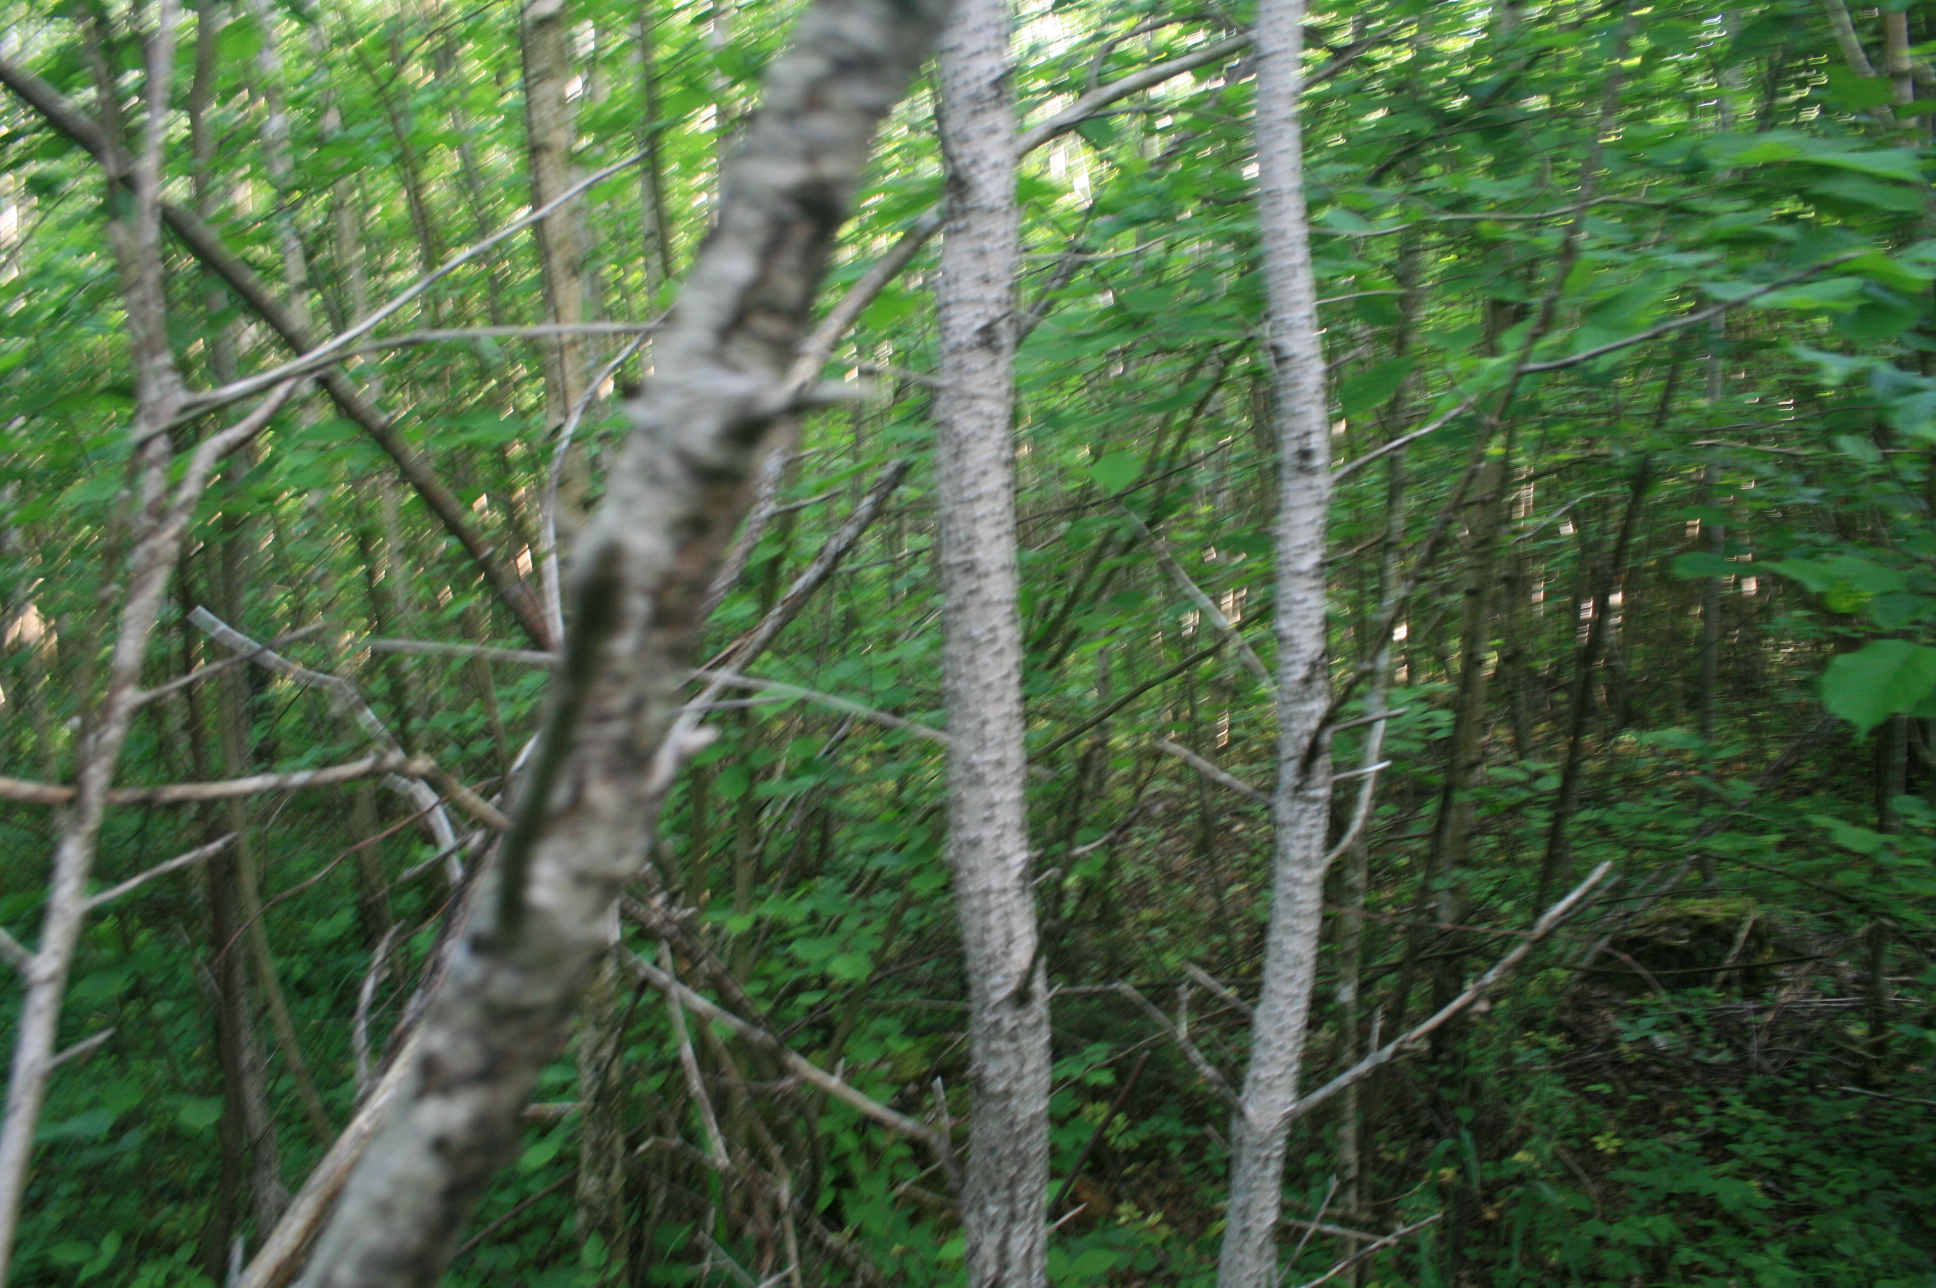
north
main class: Woodland
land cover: Broadleaved woodland
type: non-riverine alder, birch or aspen forest
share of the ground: > 75 %
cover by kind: broadleaved forest trees 95 %, herbaceous plants 5 %
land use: Forestry
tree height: > 5 m
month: June
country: LT
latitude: 55.7122
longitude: 22.1998
